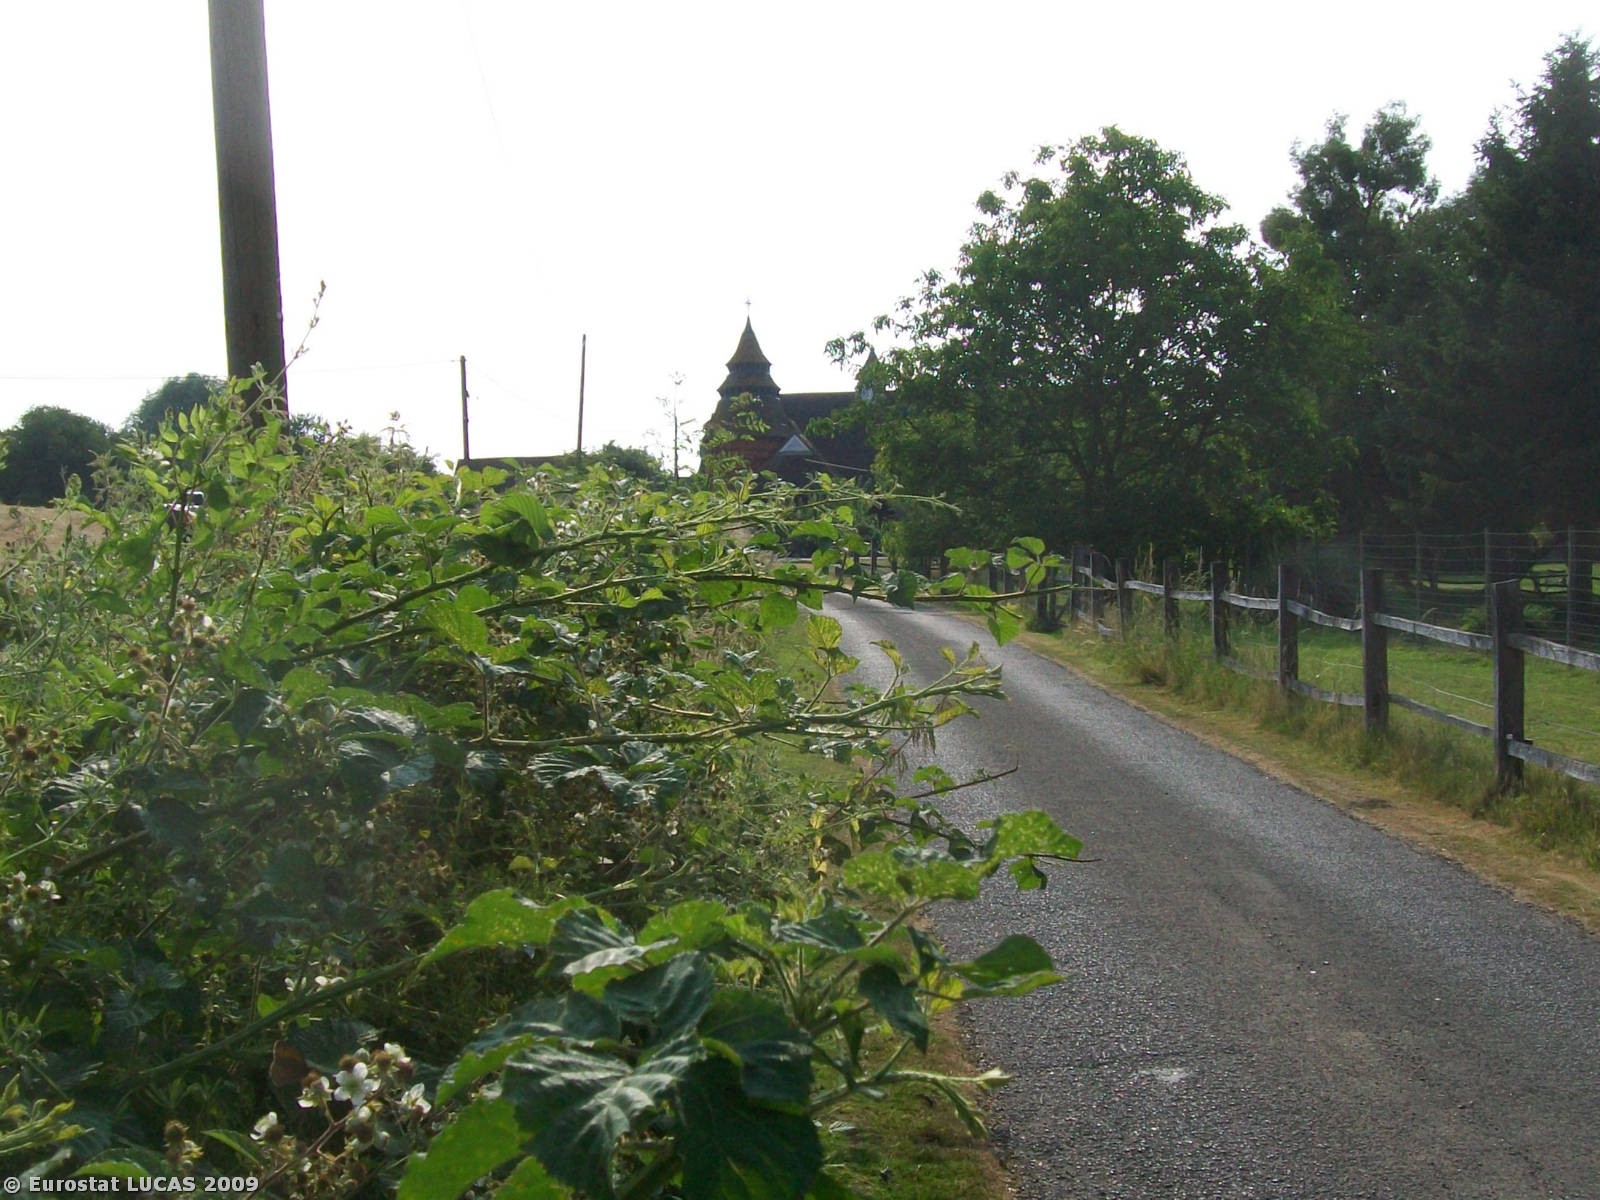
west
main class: Grassland
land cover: Grassland without tree/shrub cover
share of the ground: > 75 %
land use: Agriculture (excluding fallow land and kitchen gardens)
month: July
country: GB
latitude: 51.1166
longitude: -0.6544
